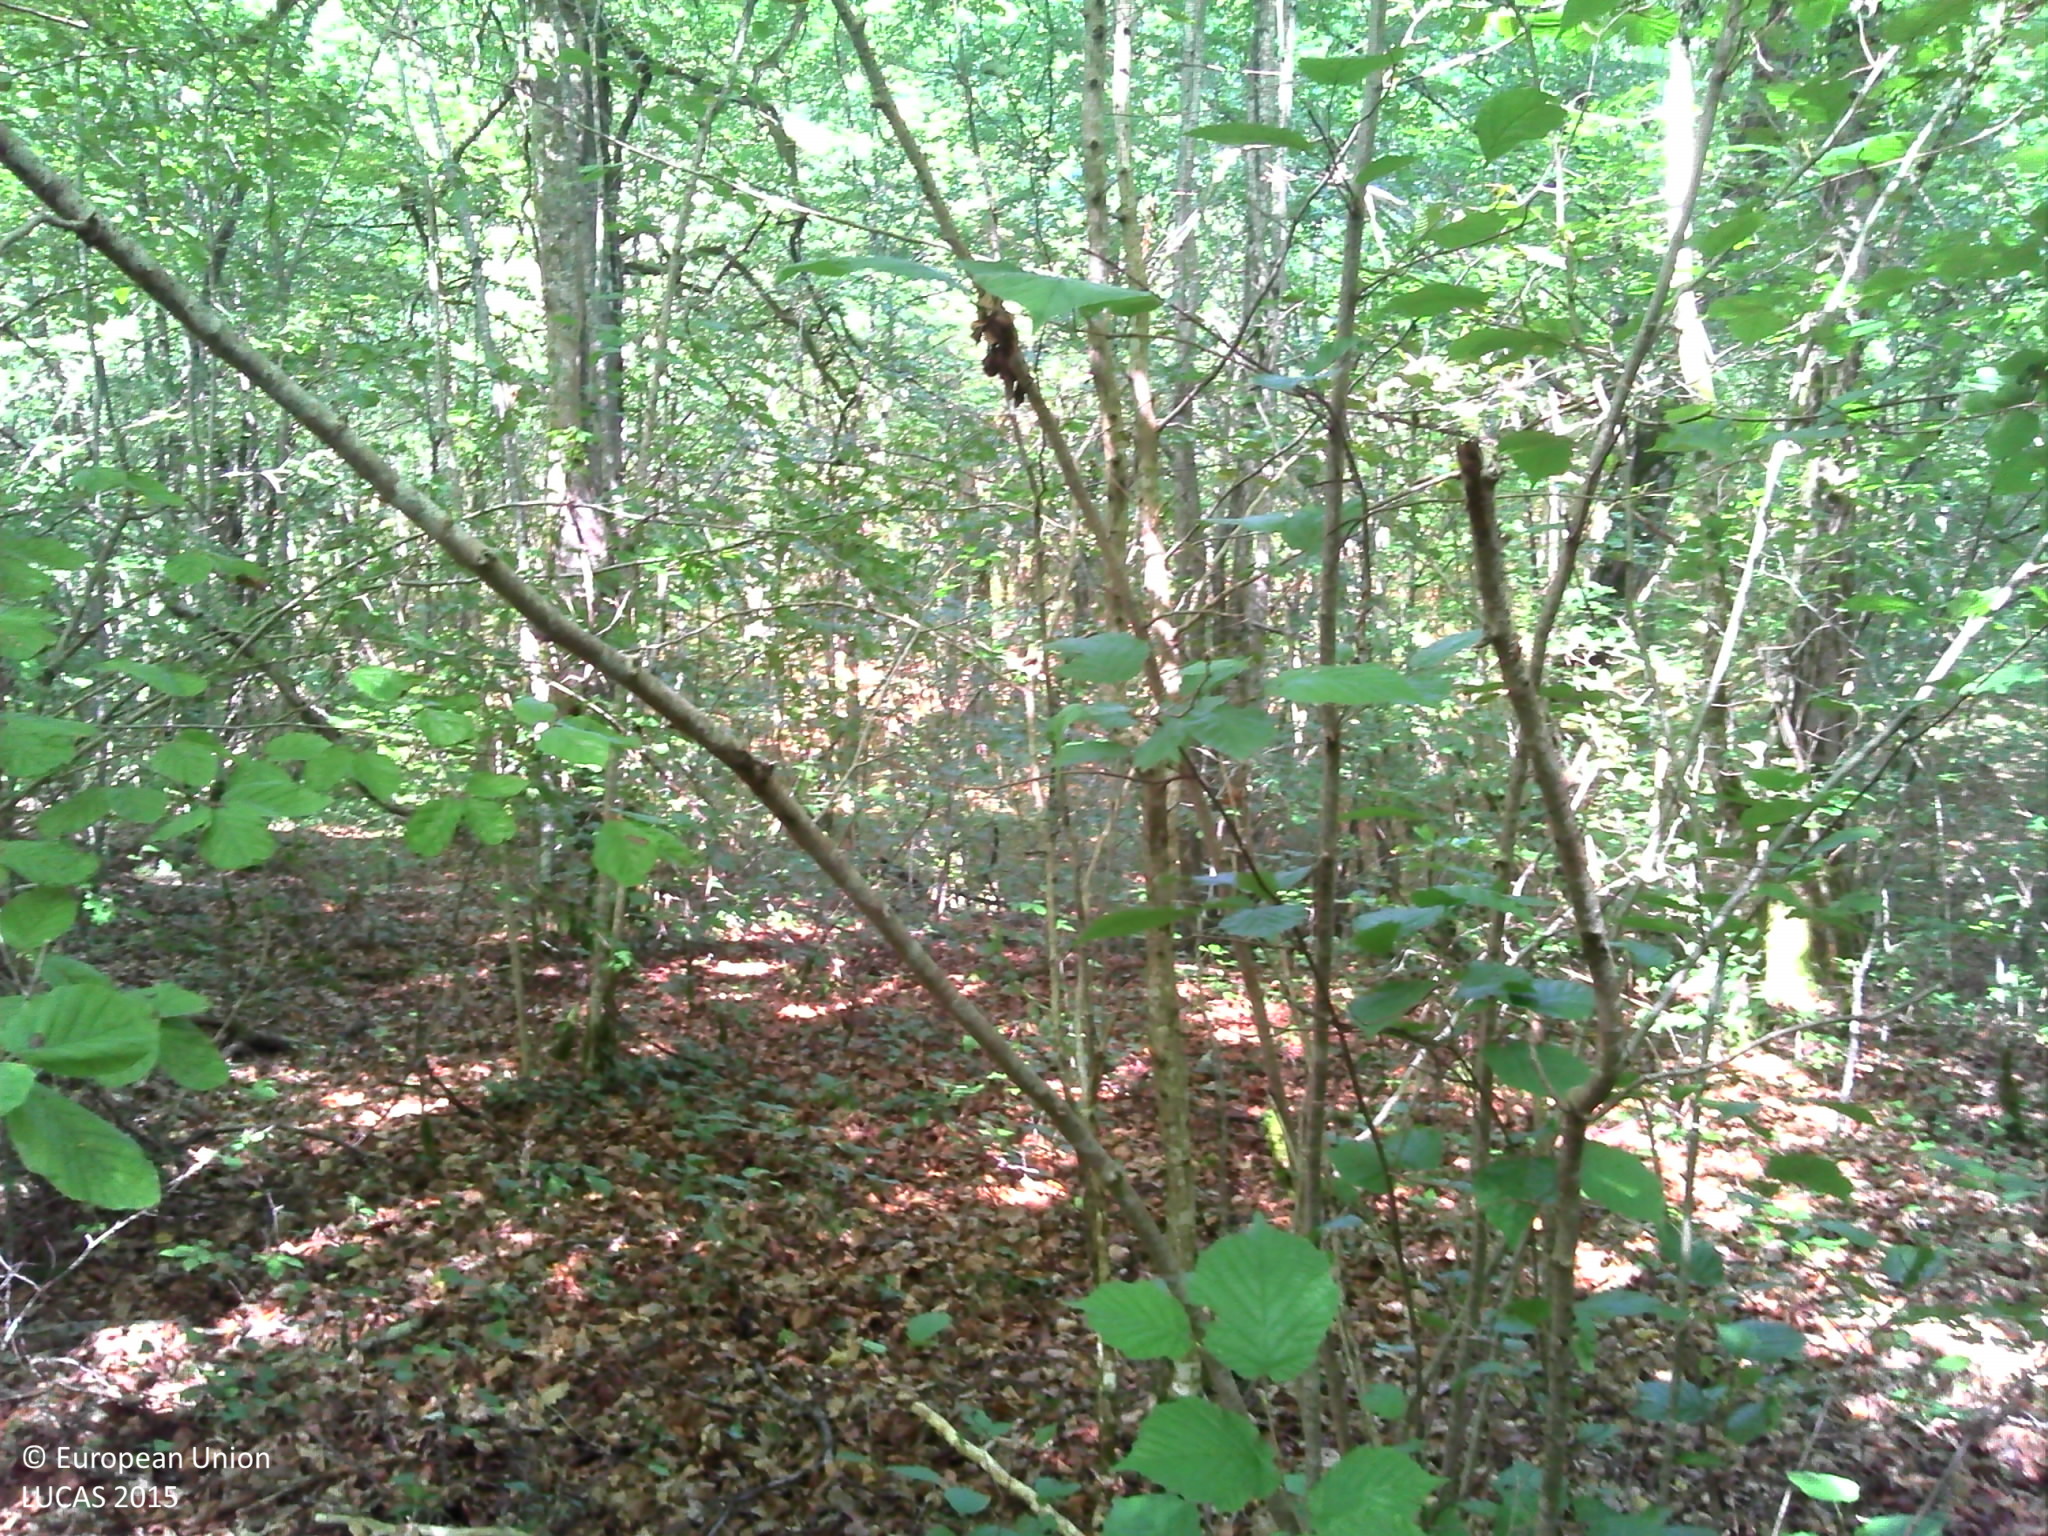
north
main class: Woodland
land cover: Broadleaved woodland
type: mesophytic deciduous forest
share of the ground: > 75 %
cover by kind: broadleaved forest trees 90 %, herbaceous plants 5 %, lichens and mosses 5 %
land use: Forestry
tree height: > 5 m
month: August
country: FR
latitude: 47.8343
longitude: 4.8824
